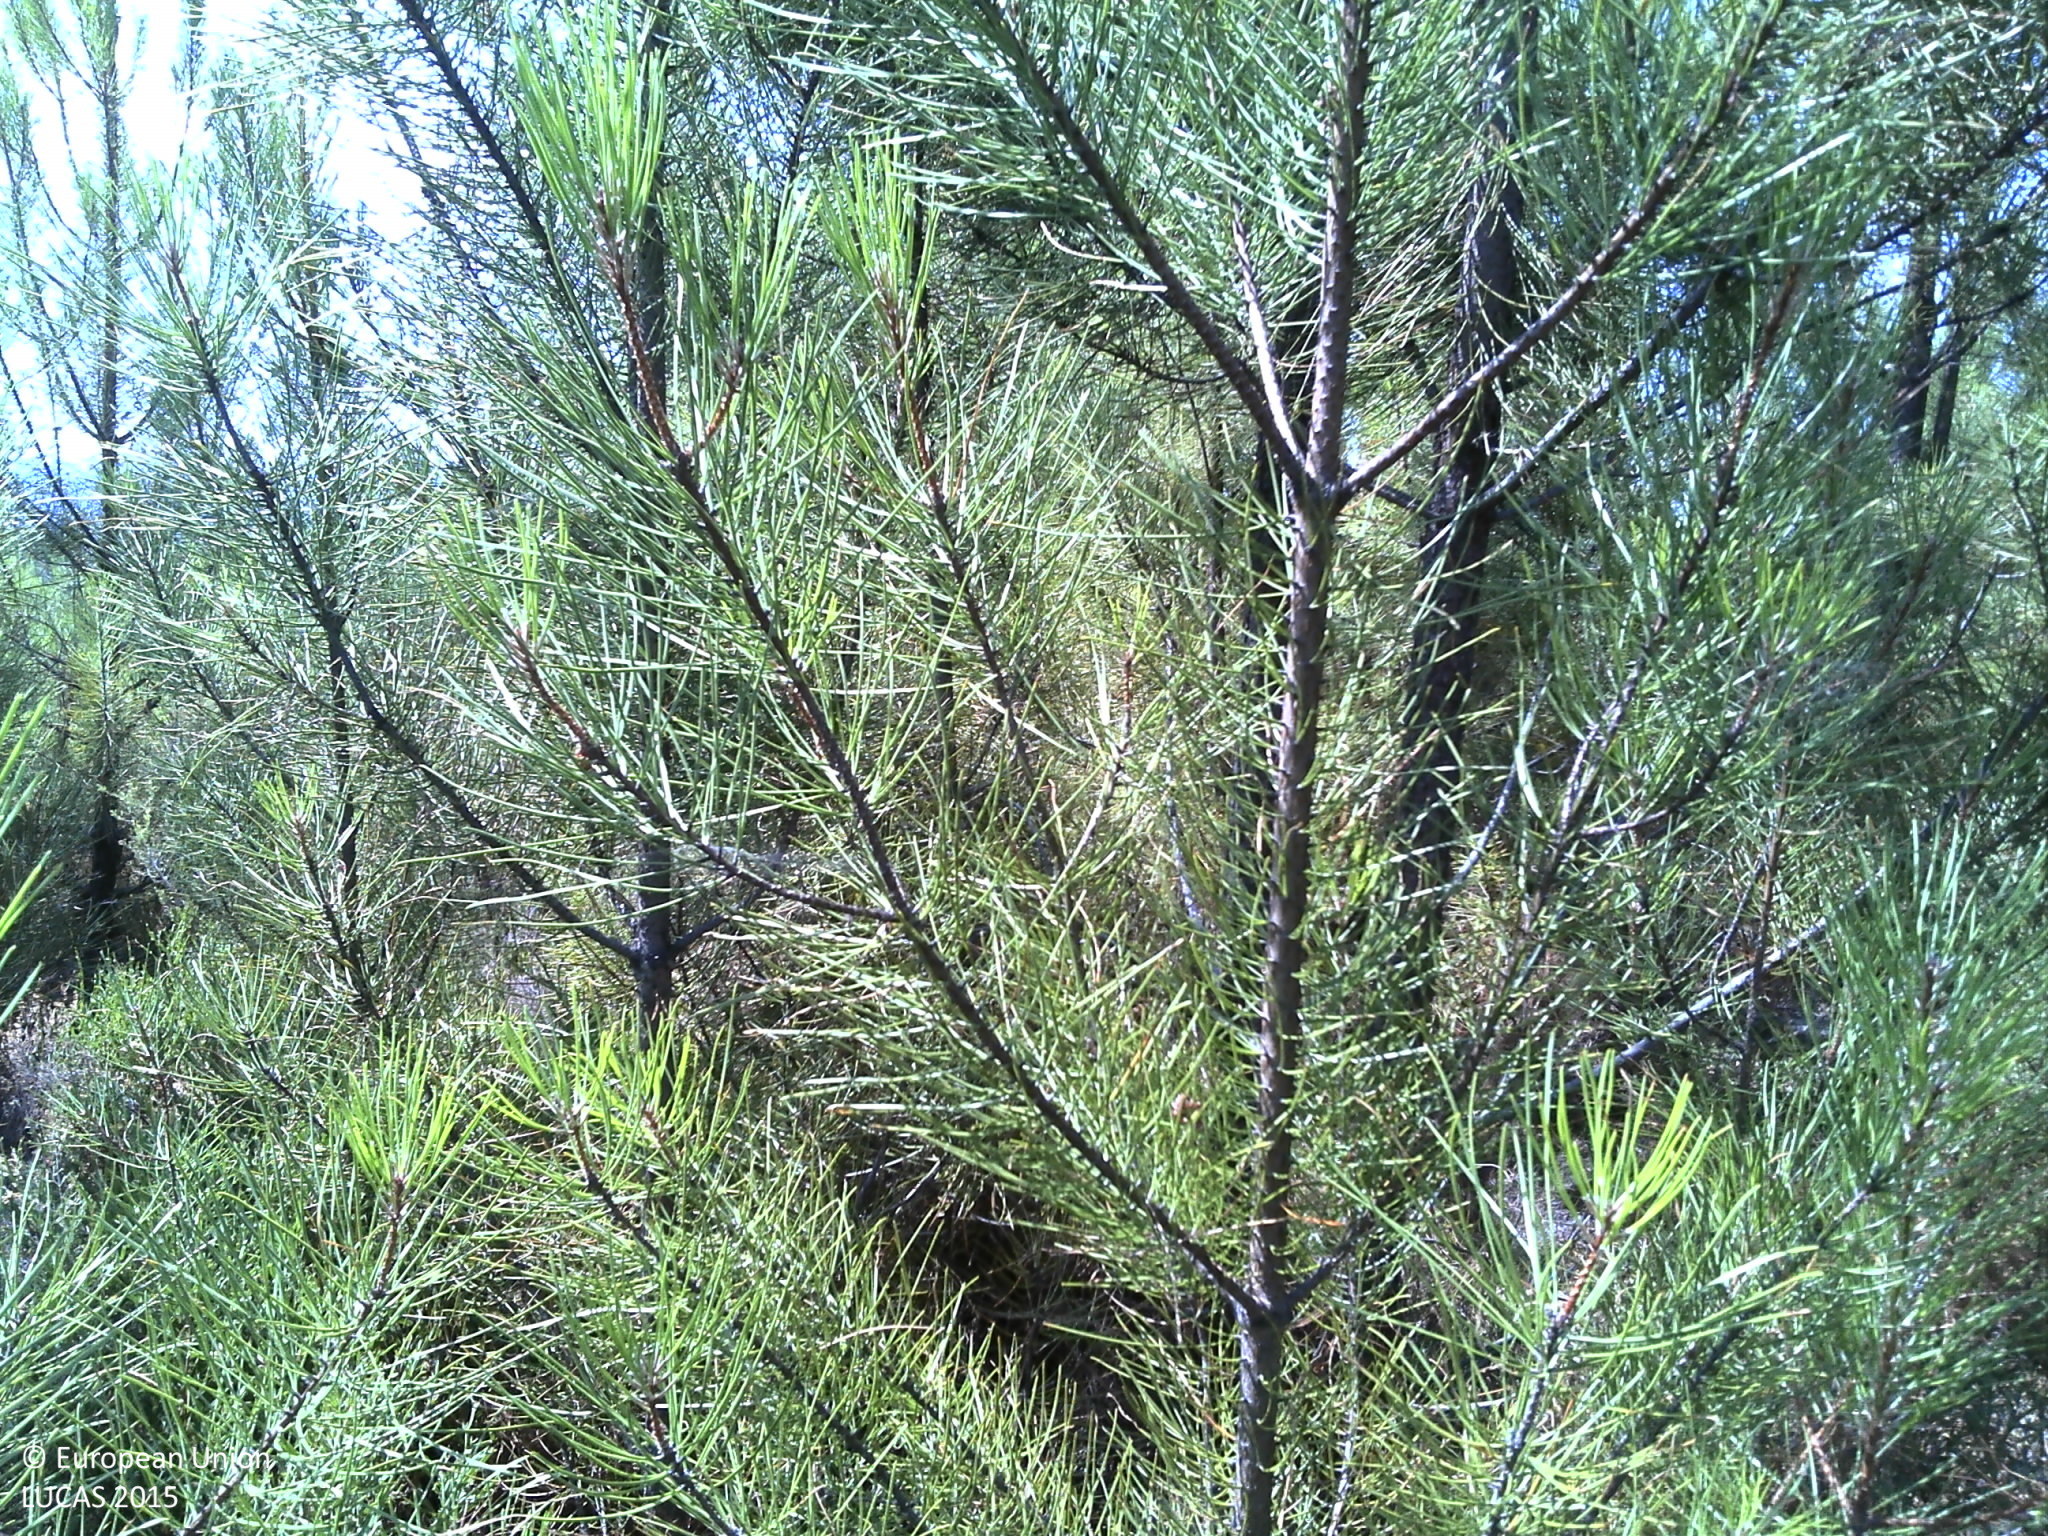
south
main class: Woodland
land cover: Pine dominated coniferous woodland
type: coniferous forest of the mediterranean region
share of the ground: 50 - 75 %
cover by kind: coniferous forest trees 55 %, unconsolidated bare surface 25 %, shrubs 20 %
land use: Forestry
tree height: < 5 m
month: July
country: PT
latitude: 39.8199
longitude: -7.8299
